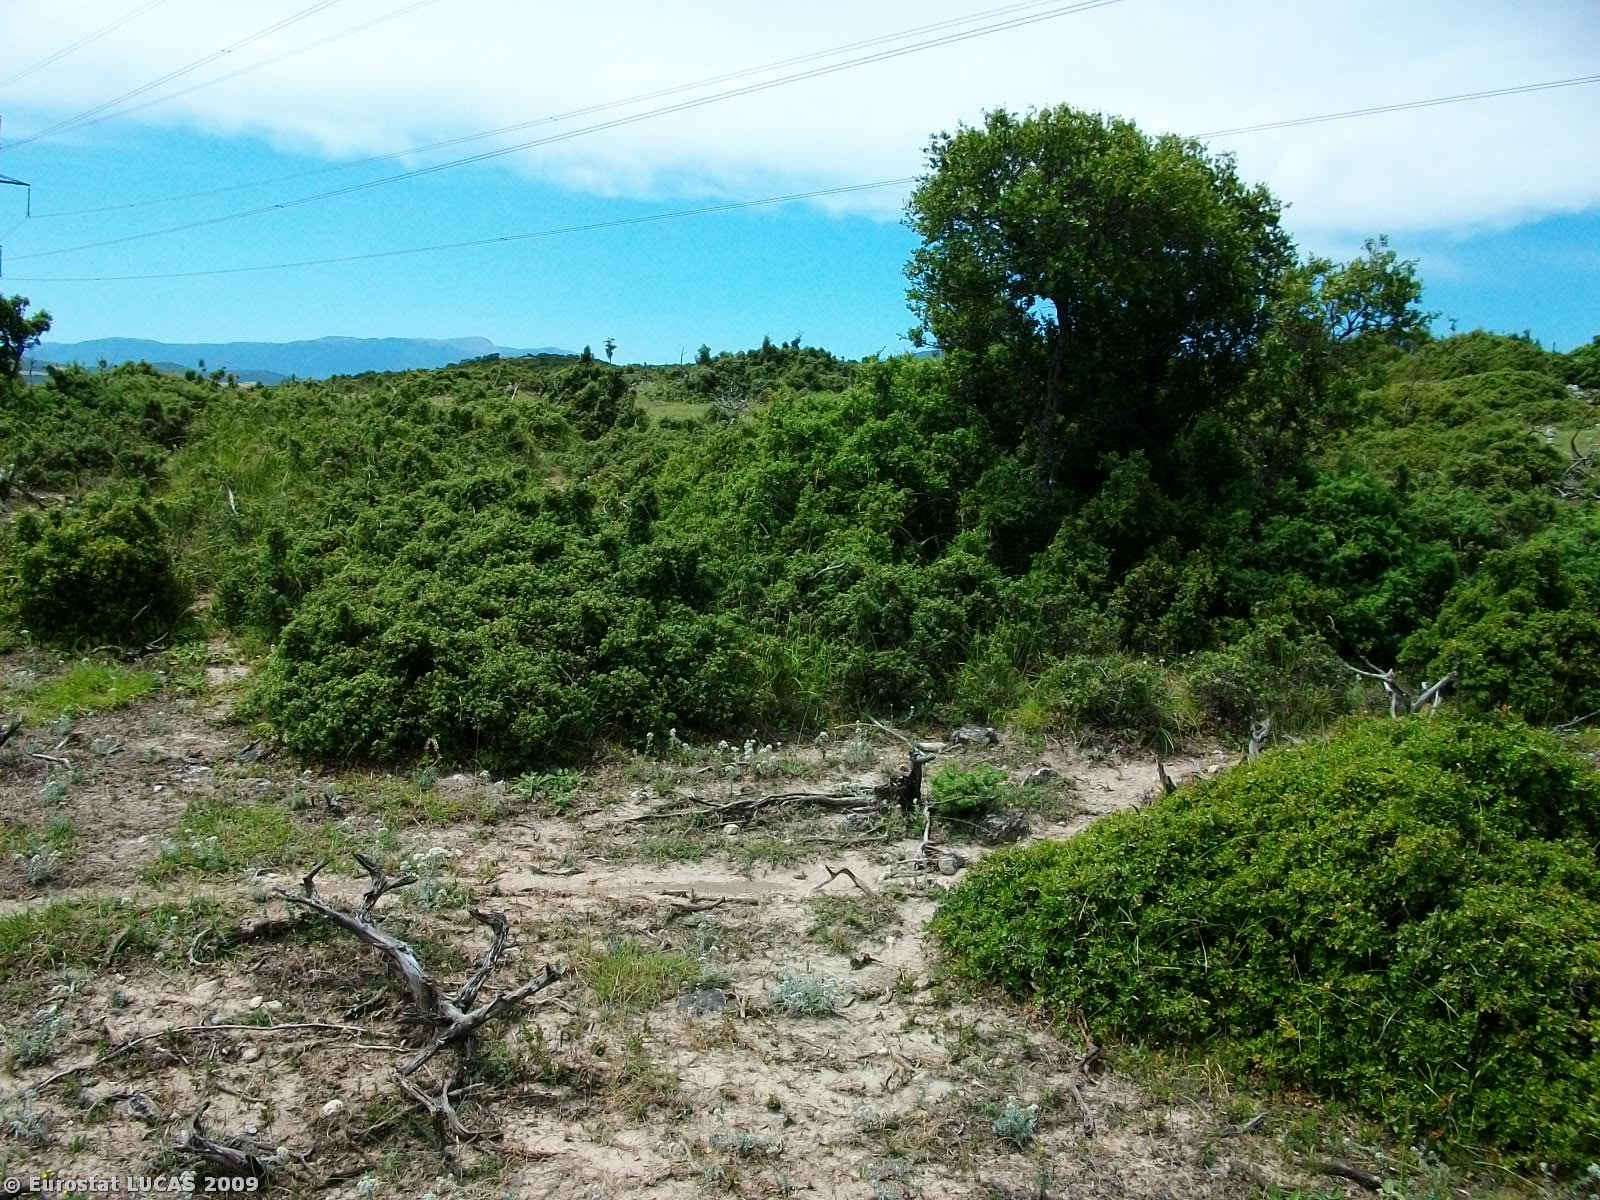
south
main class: Shrubland
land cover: Shrubland without tree cover
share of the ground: > 75 %
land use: Unused
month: July
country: GR
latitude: 40.1360
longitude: 21.8090
